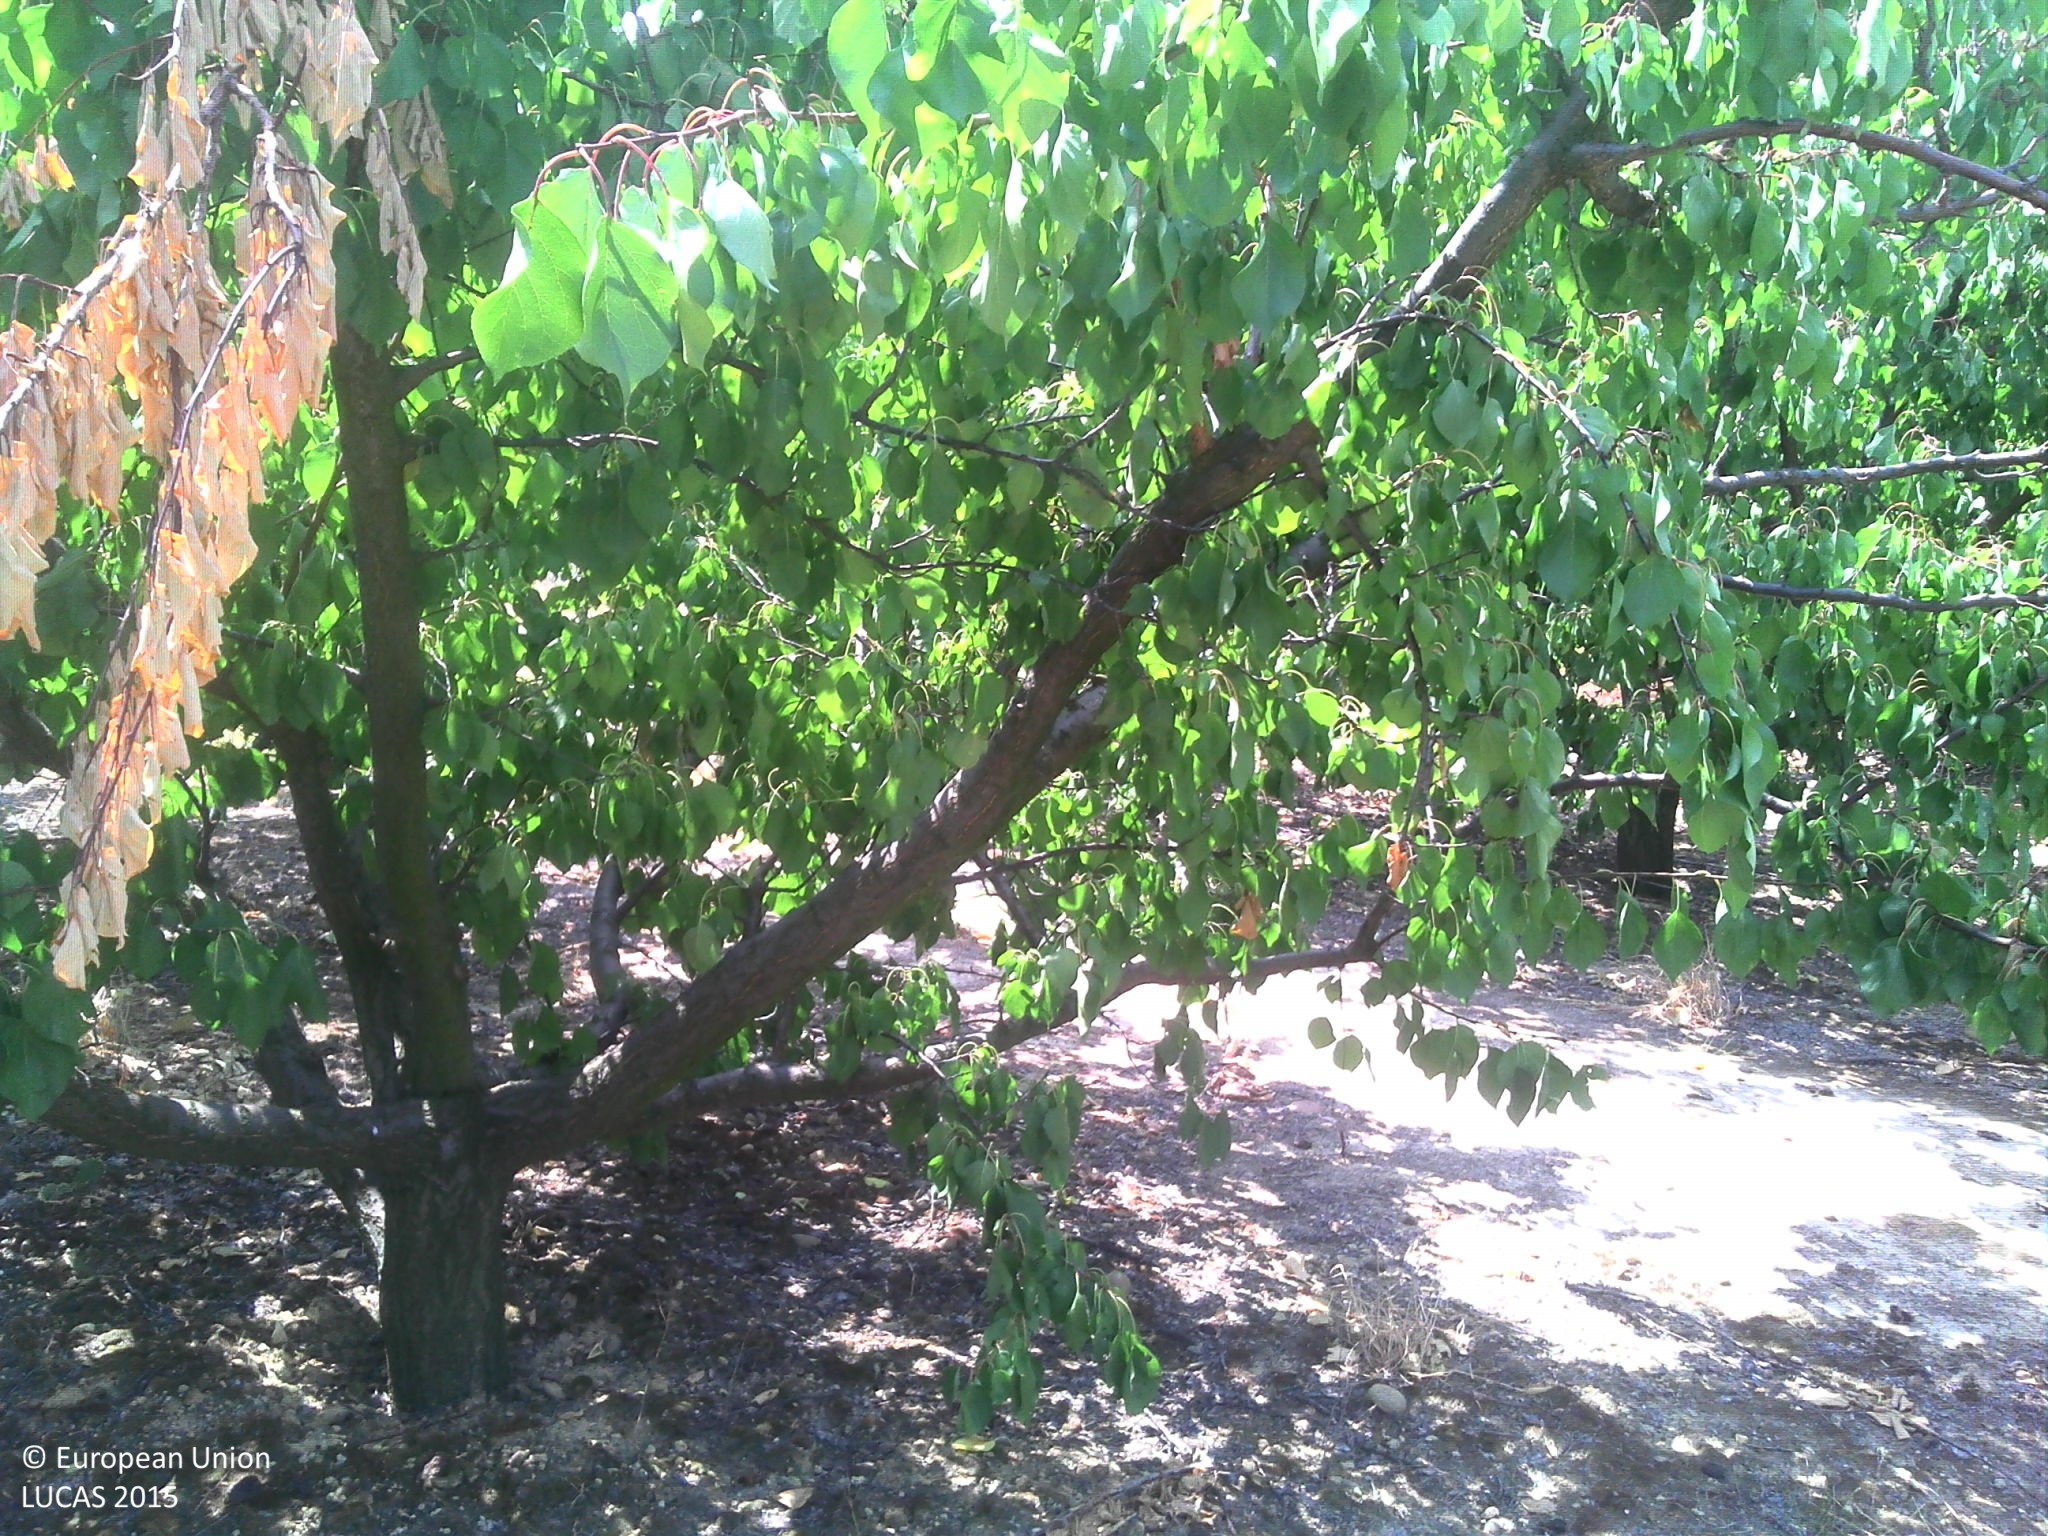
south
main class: Cropland
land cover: Other fruit trees and berries
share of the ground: > 75 %
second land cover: Other bare soil
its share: > 75 %
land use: Agriculture (excluding fallow land and kitchen gardens)
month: July
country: FR
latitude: 44.3199
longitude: 4.6284
